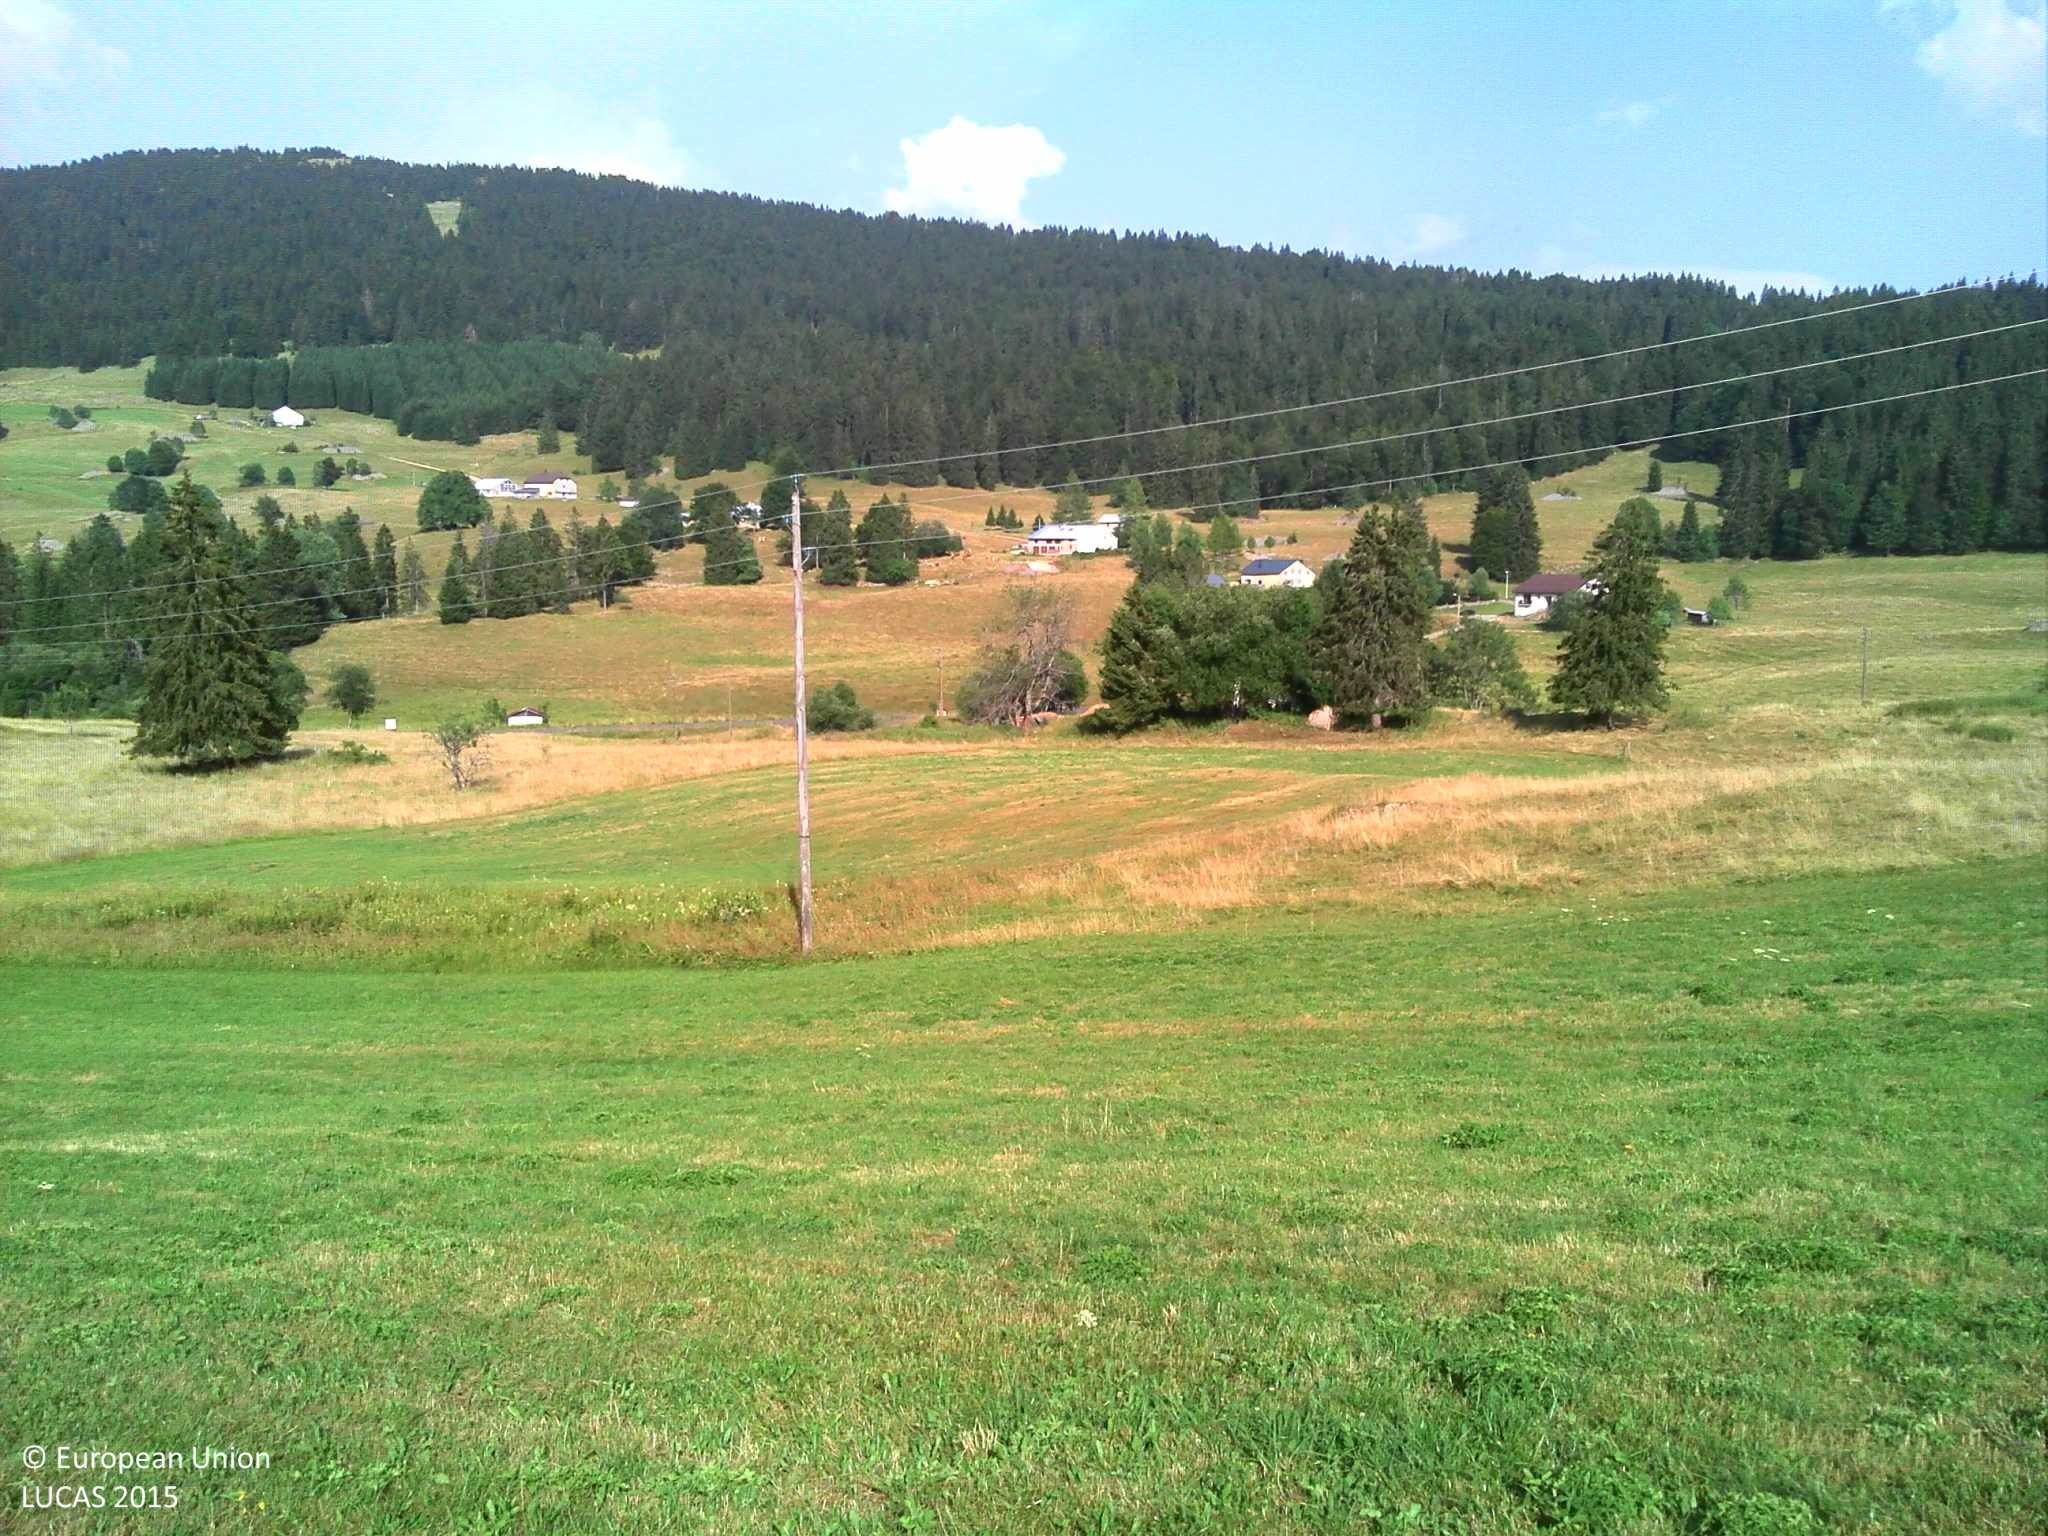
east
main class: Grassland
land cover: Grassland without tree/shrub cover
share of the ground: > 75 %
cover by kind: herbaceous plants 100 %
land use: Agriculture (excluding fallow land and kitchen gardens)
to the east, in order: Grassland without tree/shrub cover; Electric lines; Grassland without tree/shrub cover; Fences; Grassland without tree/shrub cover; Fences; Grassland without tree/shrub cover; Fences; Grassland without tree/shrub cover; Fences; Grassland without tree/shrub cover; Electric lines; Grassland without tree/shrub cover
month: July
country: FR
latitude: 46.4778
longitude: 6.0825
